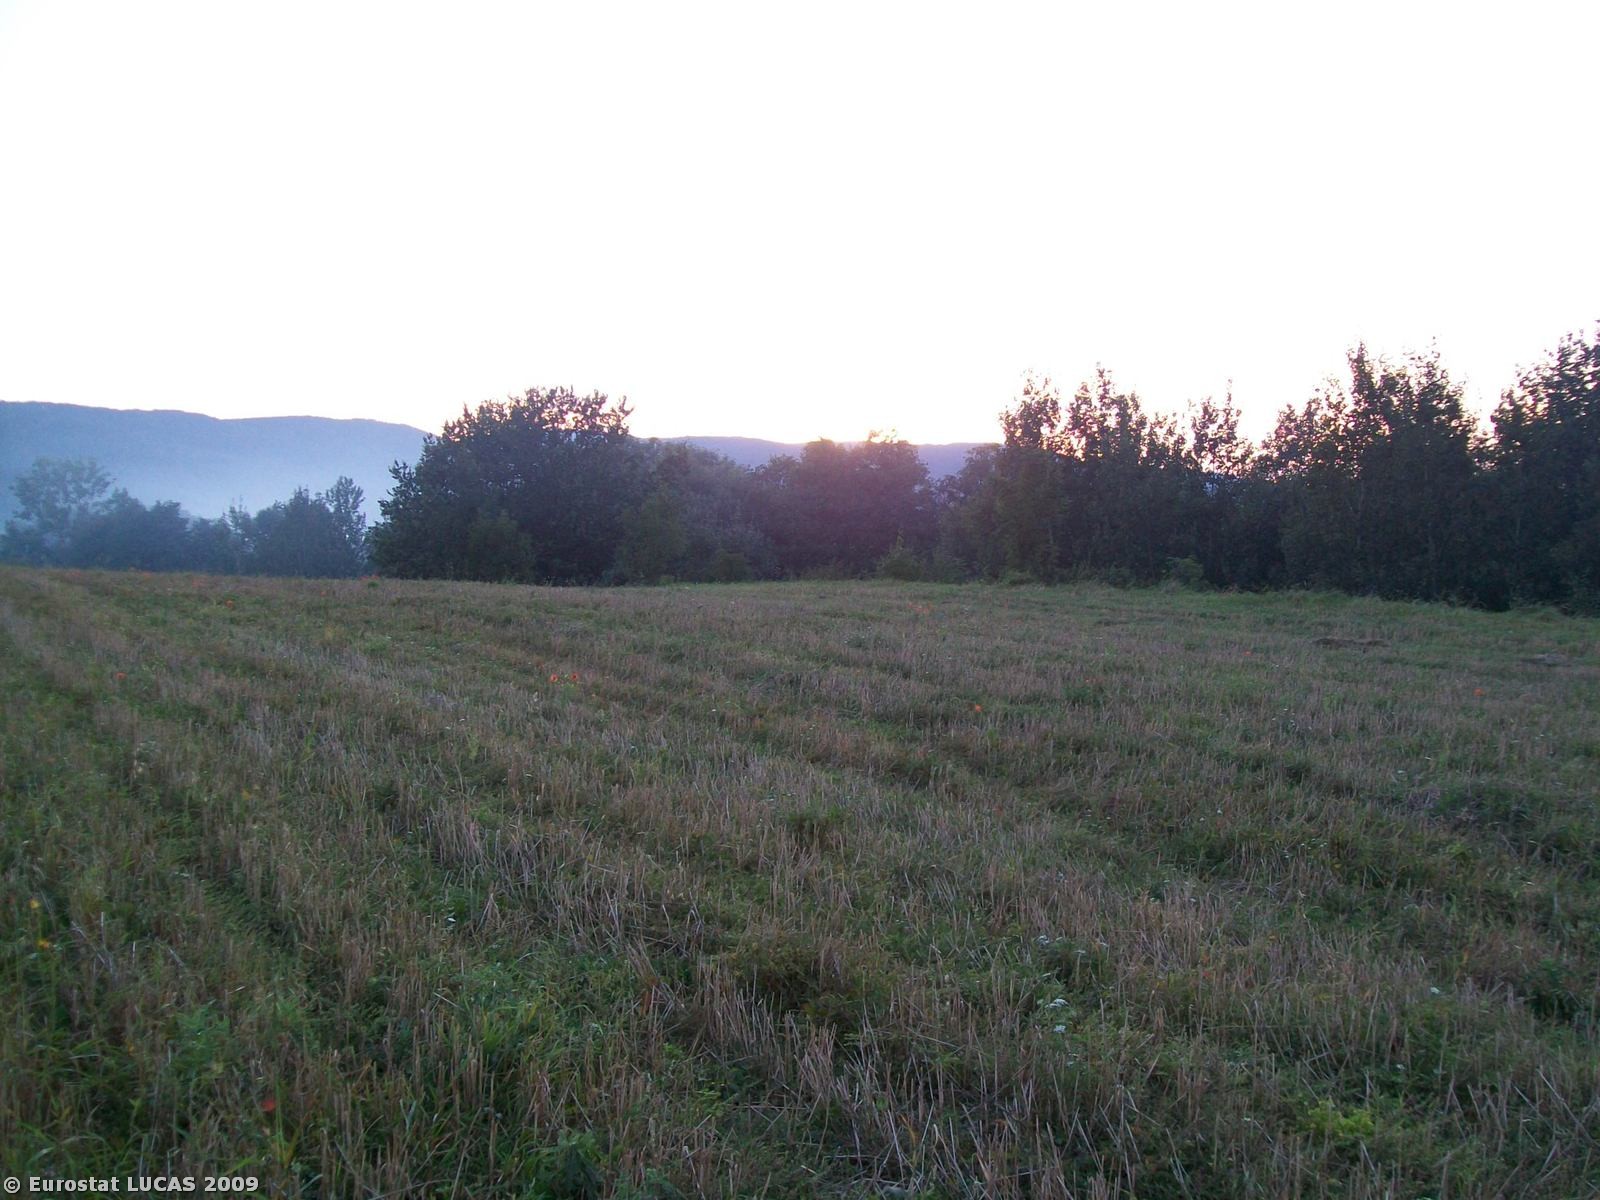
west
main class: Cropland
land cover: Common wheat
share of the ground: < 10 %
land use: Agriculture (excluding fallow land and kitchen gardens)
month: July
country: PL
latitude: 50.3343
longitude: 16.6253
